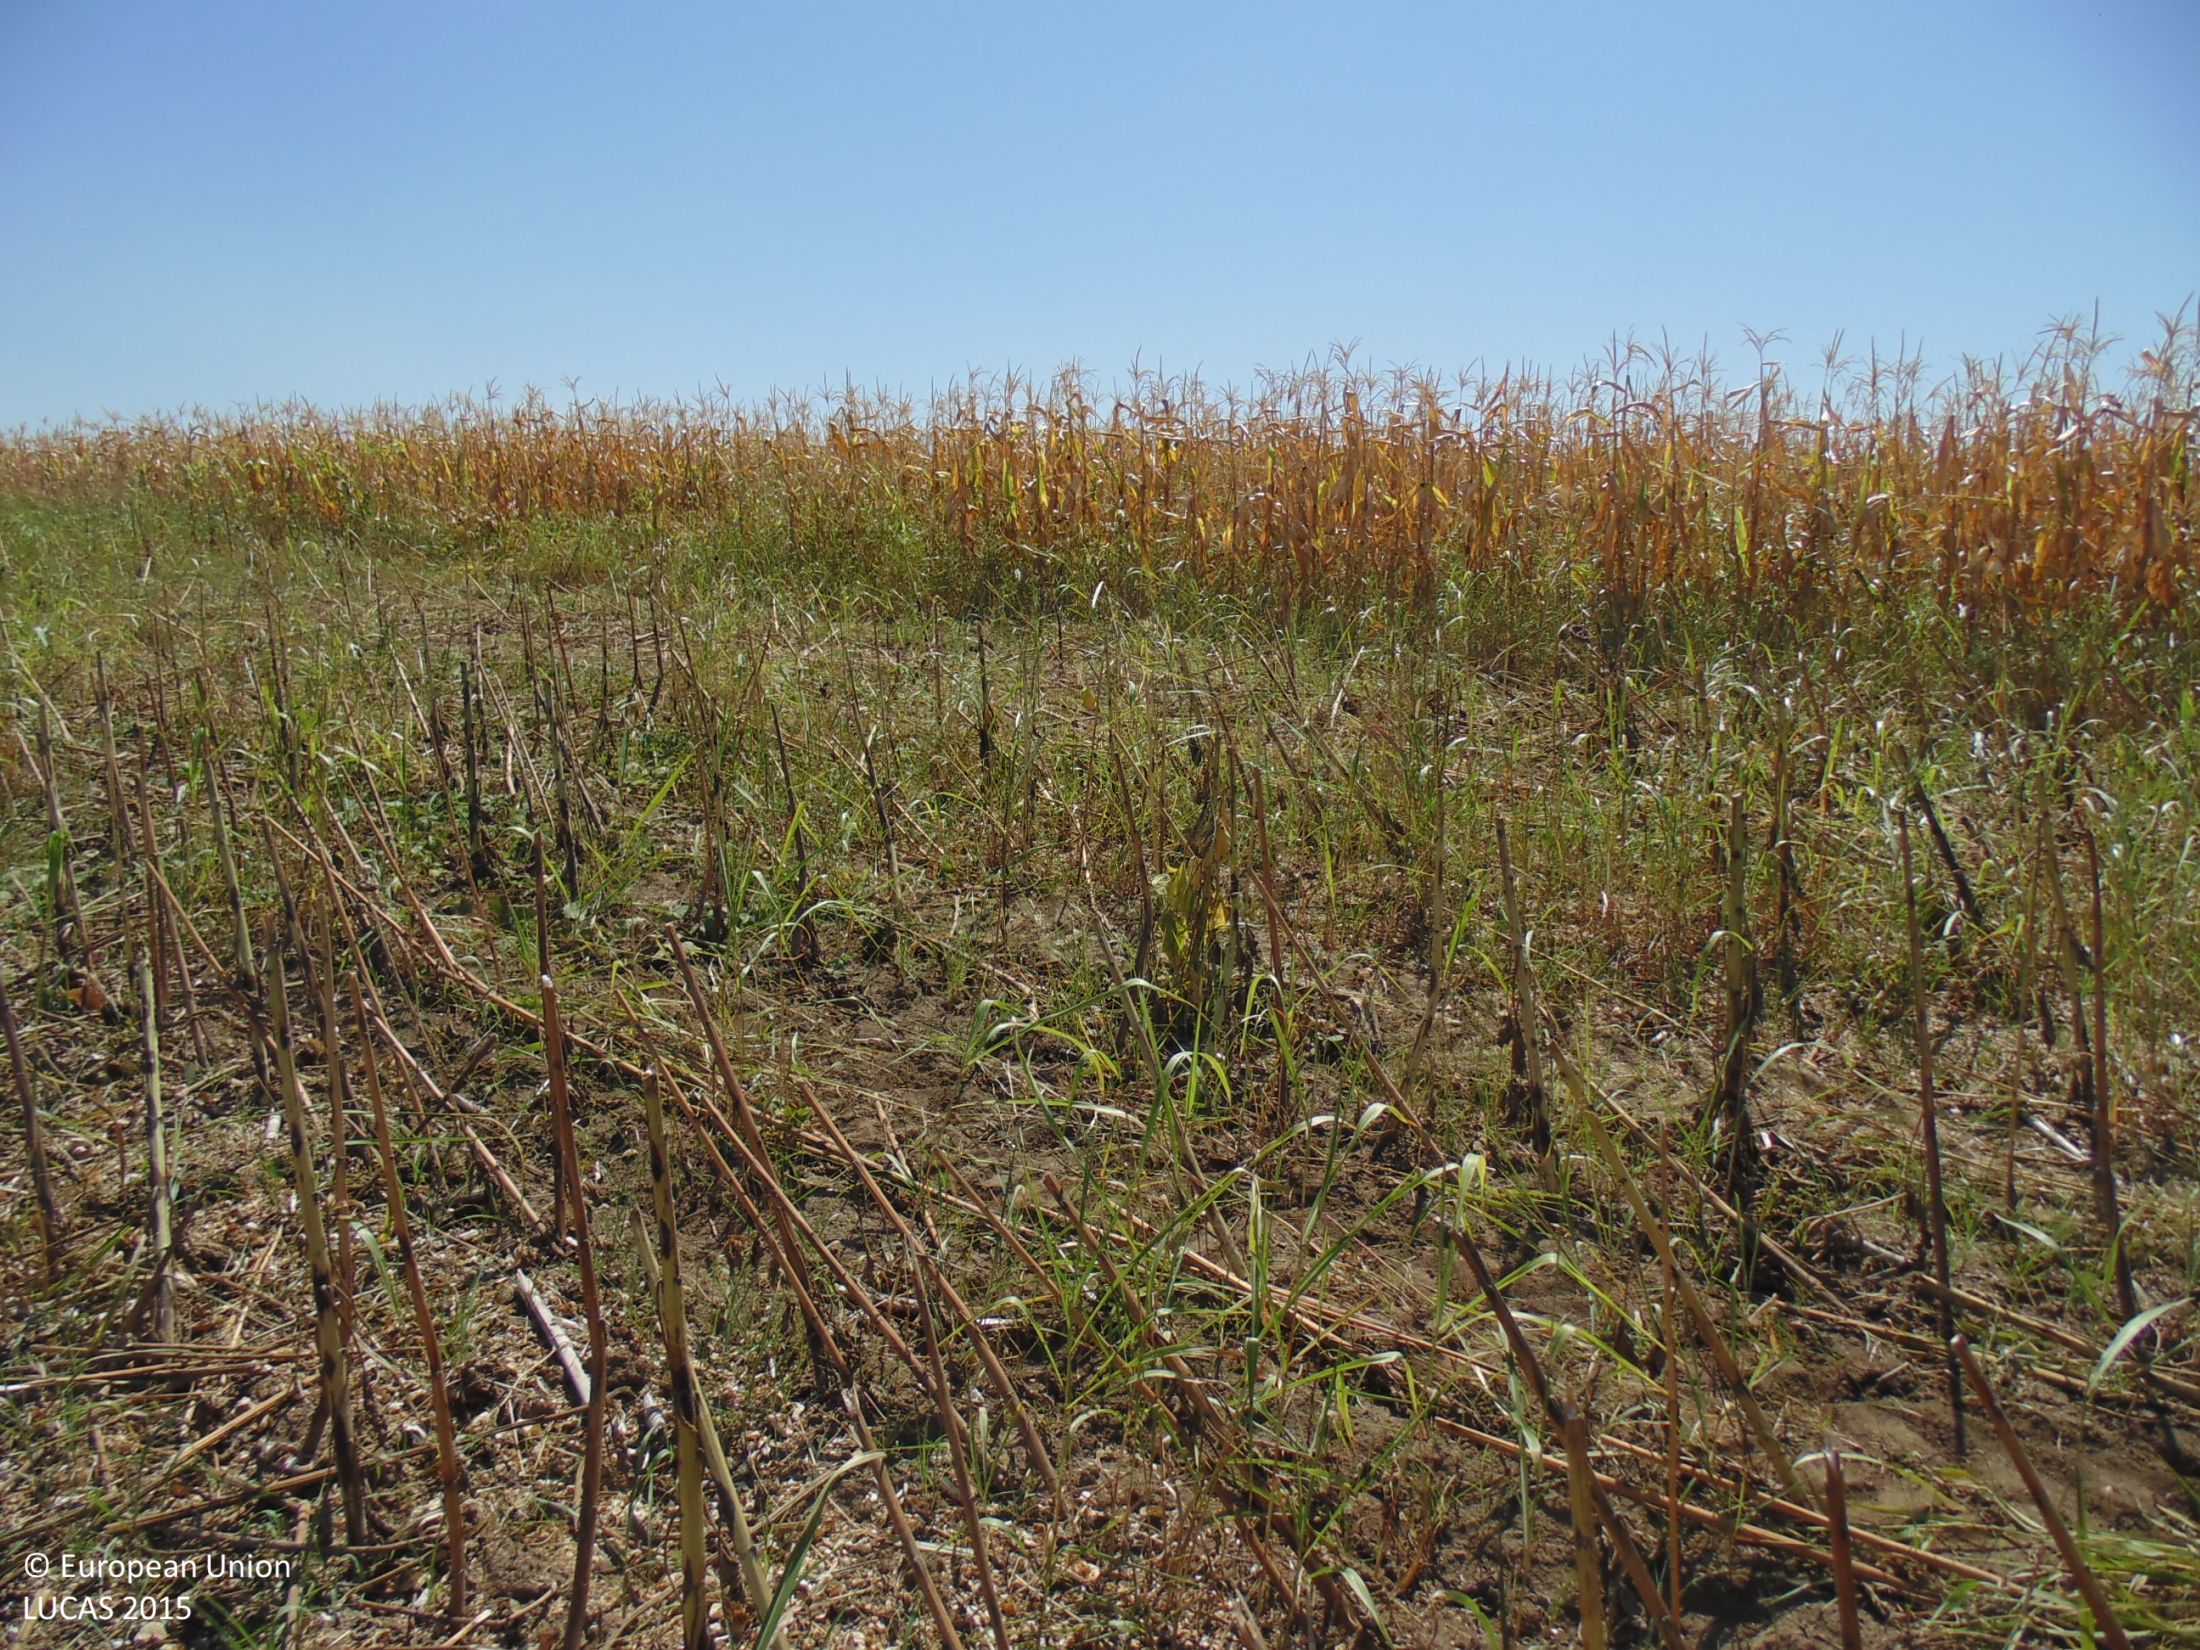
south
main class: Cropland
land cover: Sunflower
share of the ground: 50 - 75 %
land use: Agriculture (excluding fallow land and kitchen gardens)
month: September
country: BG
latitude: 43.9341
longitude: 27.0788
